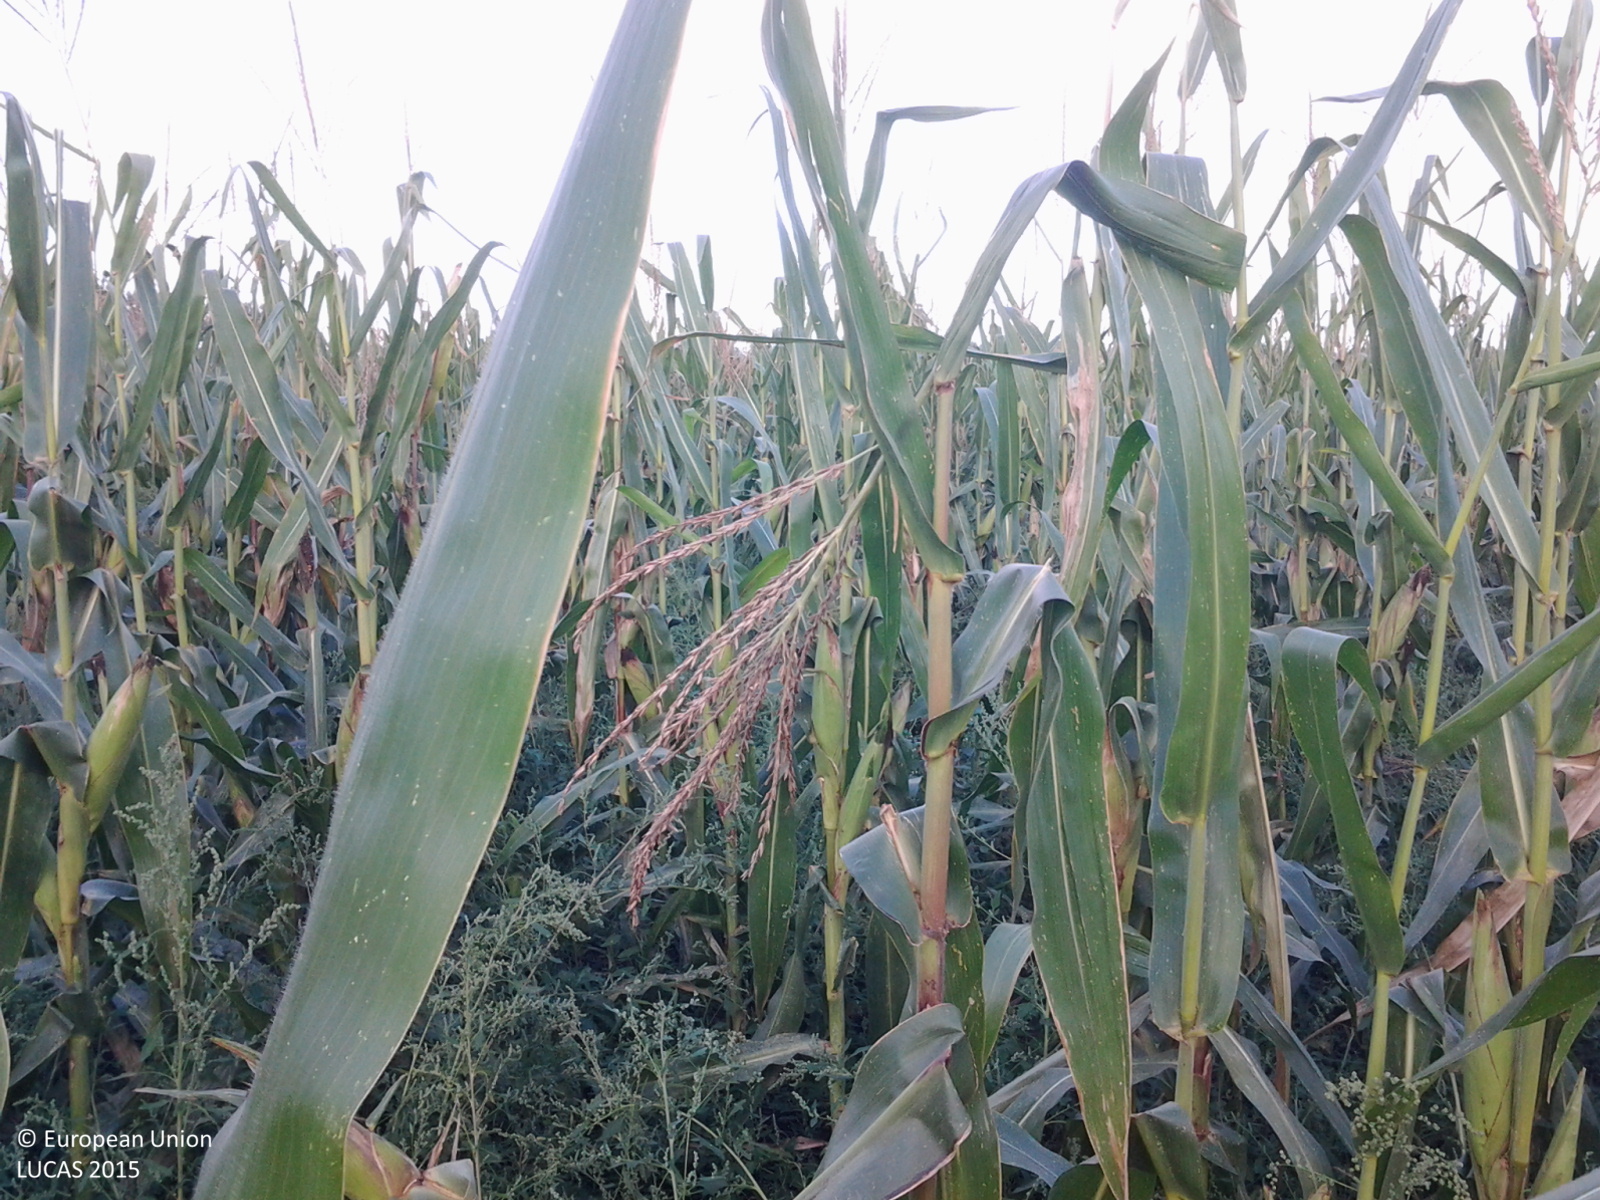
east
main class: Cropland
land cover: Maize
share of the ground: > 75 %
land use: Agriculture (excluding fallow land and kitchen gardens)
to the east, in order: Maize; Common wheat
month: September
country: HU
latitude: 47.5632
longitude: 20.2496
